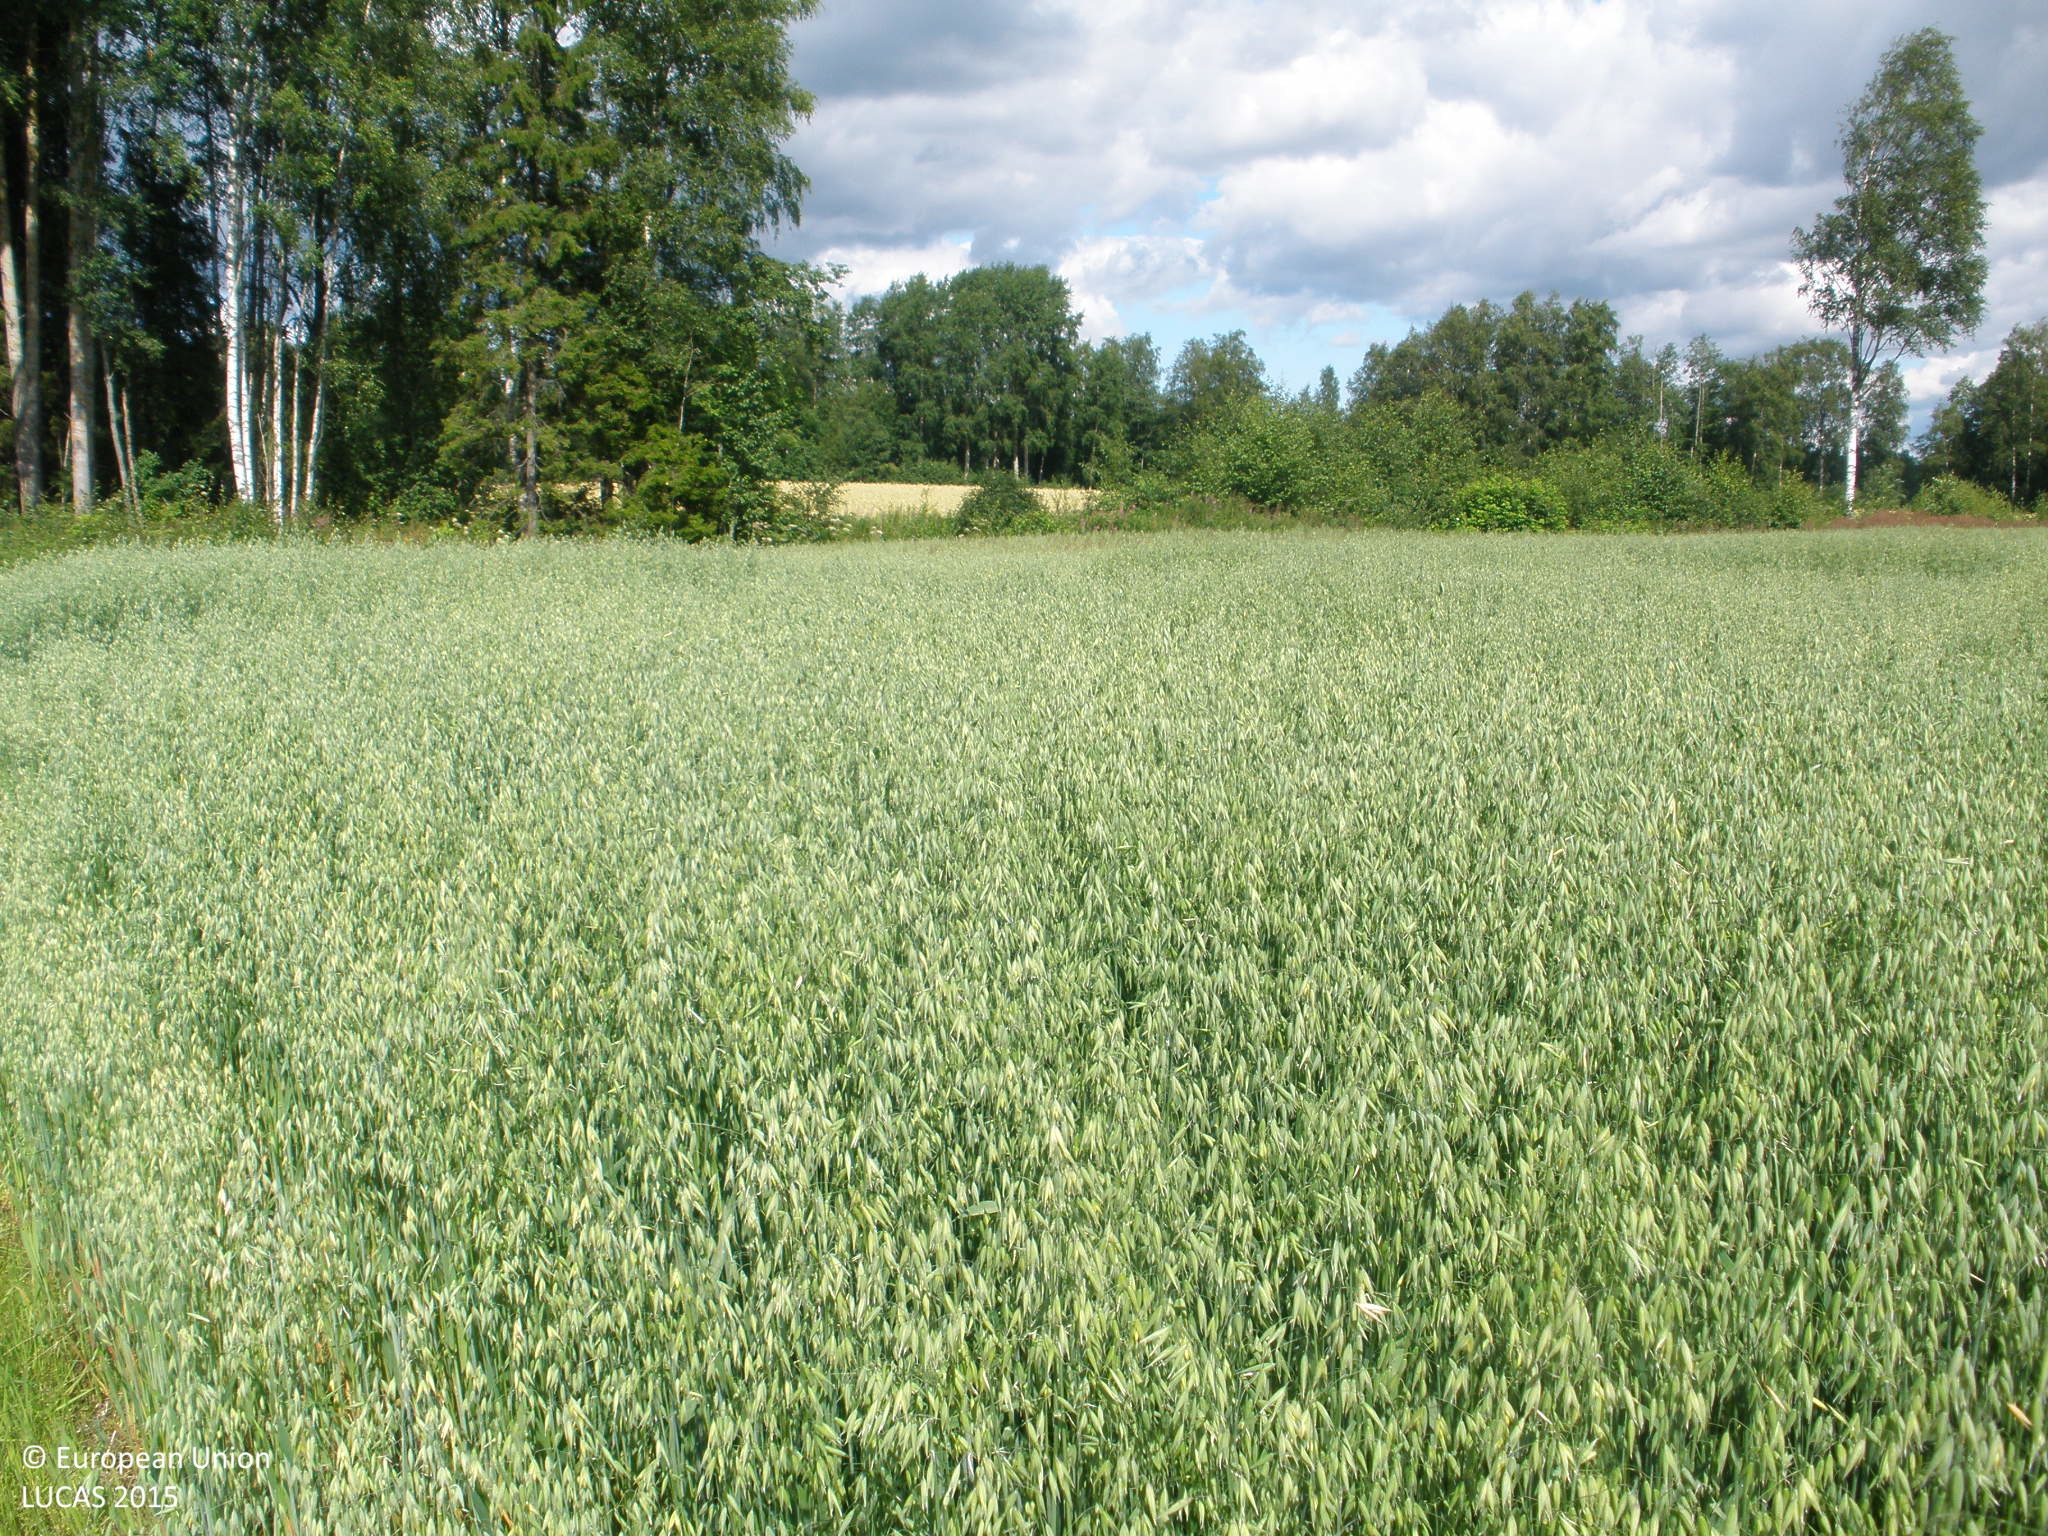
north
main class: Cropland
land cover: Oats
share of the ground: > 75 %
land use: Agriculture (excluding fallow land and kitchen gardens)
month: August
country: FI
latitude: 60.8777
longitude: 24.3012
